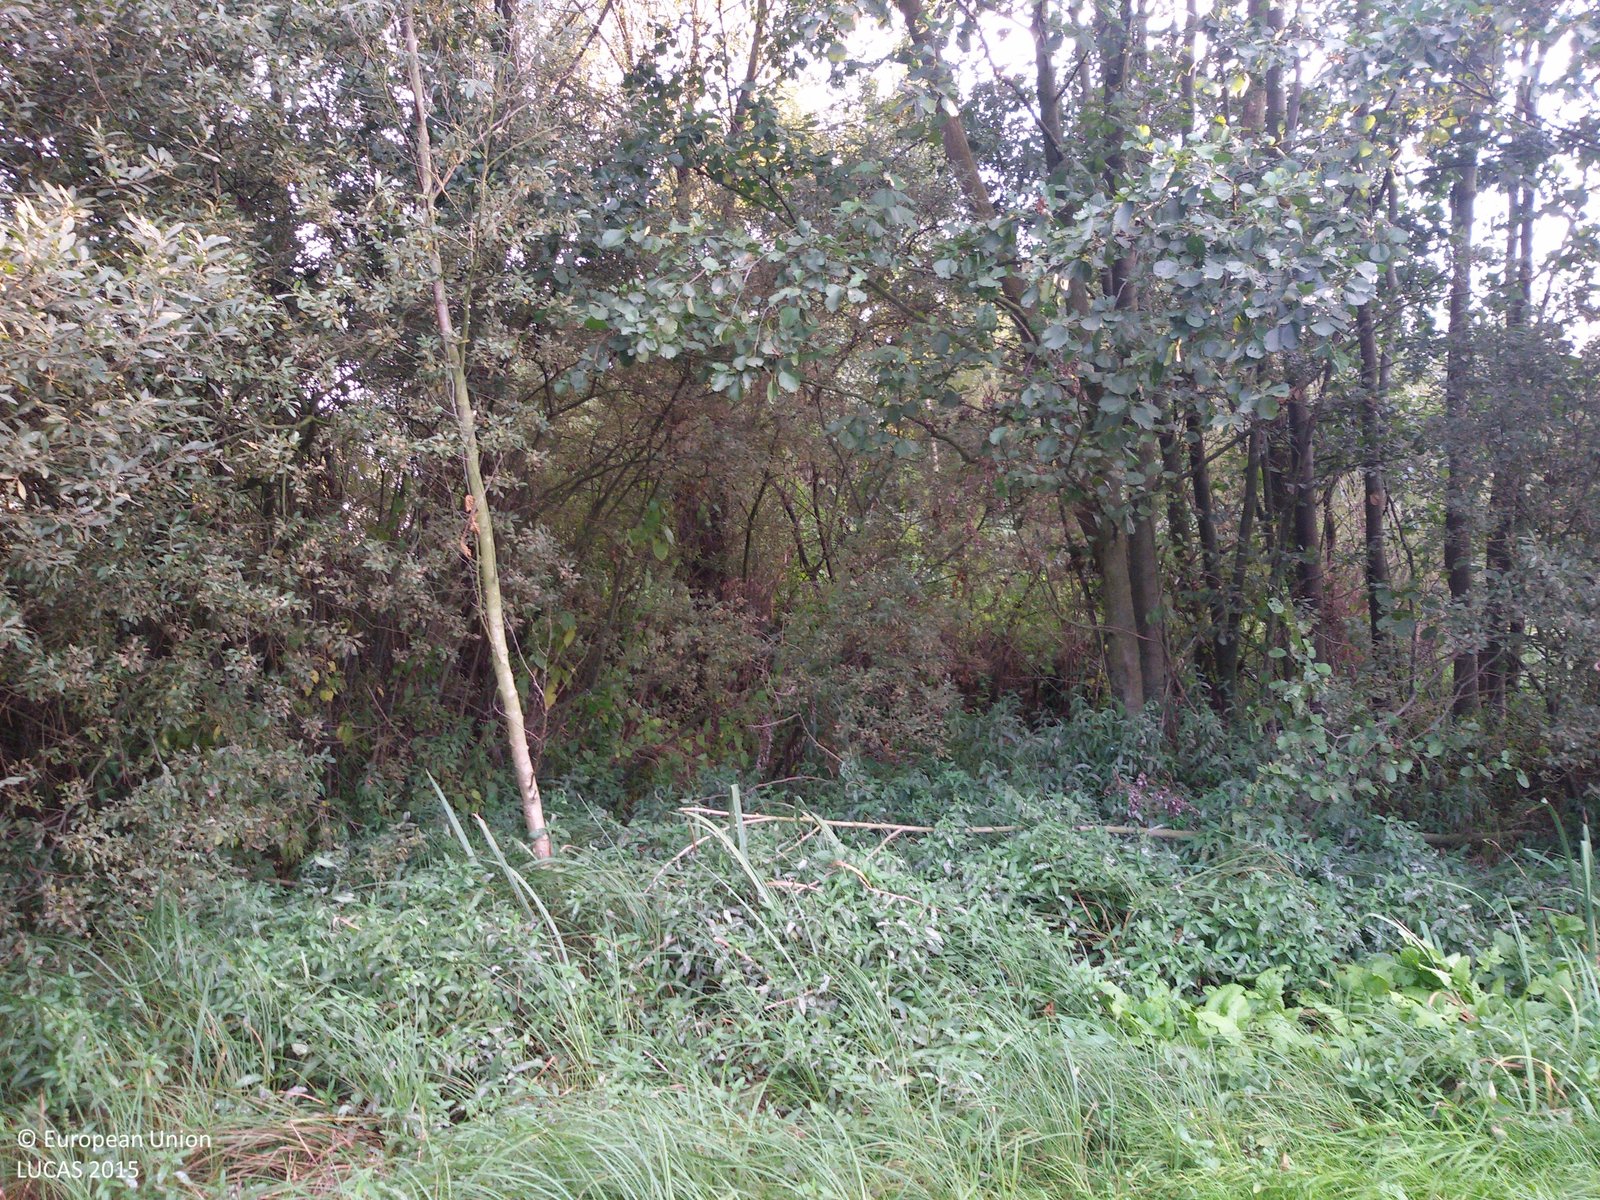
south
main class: Grassland
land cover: Grassland without tree/shrub cover
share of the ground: > 75 %
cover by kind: herbaceous plants 100 %
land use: Agriculture (excluding fallow land and kitchen gardens)
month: September
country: PL
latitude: 52.2003
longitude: 17.9602
